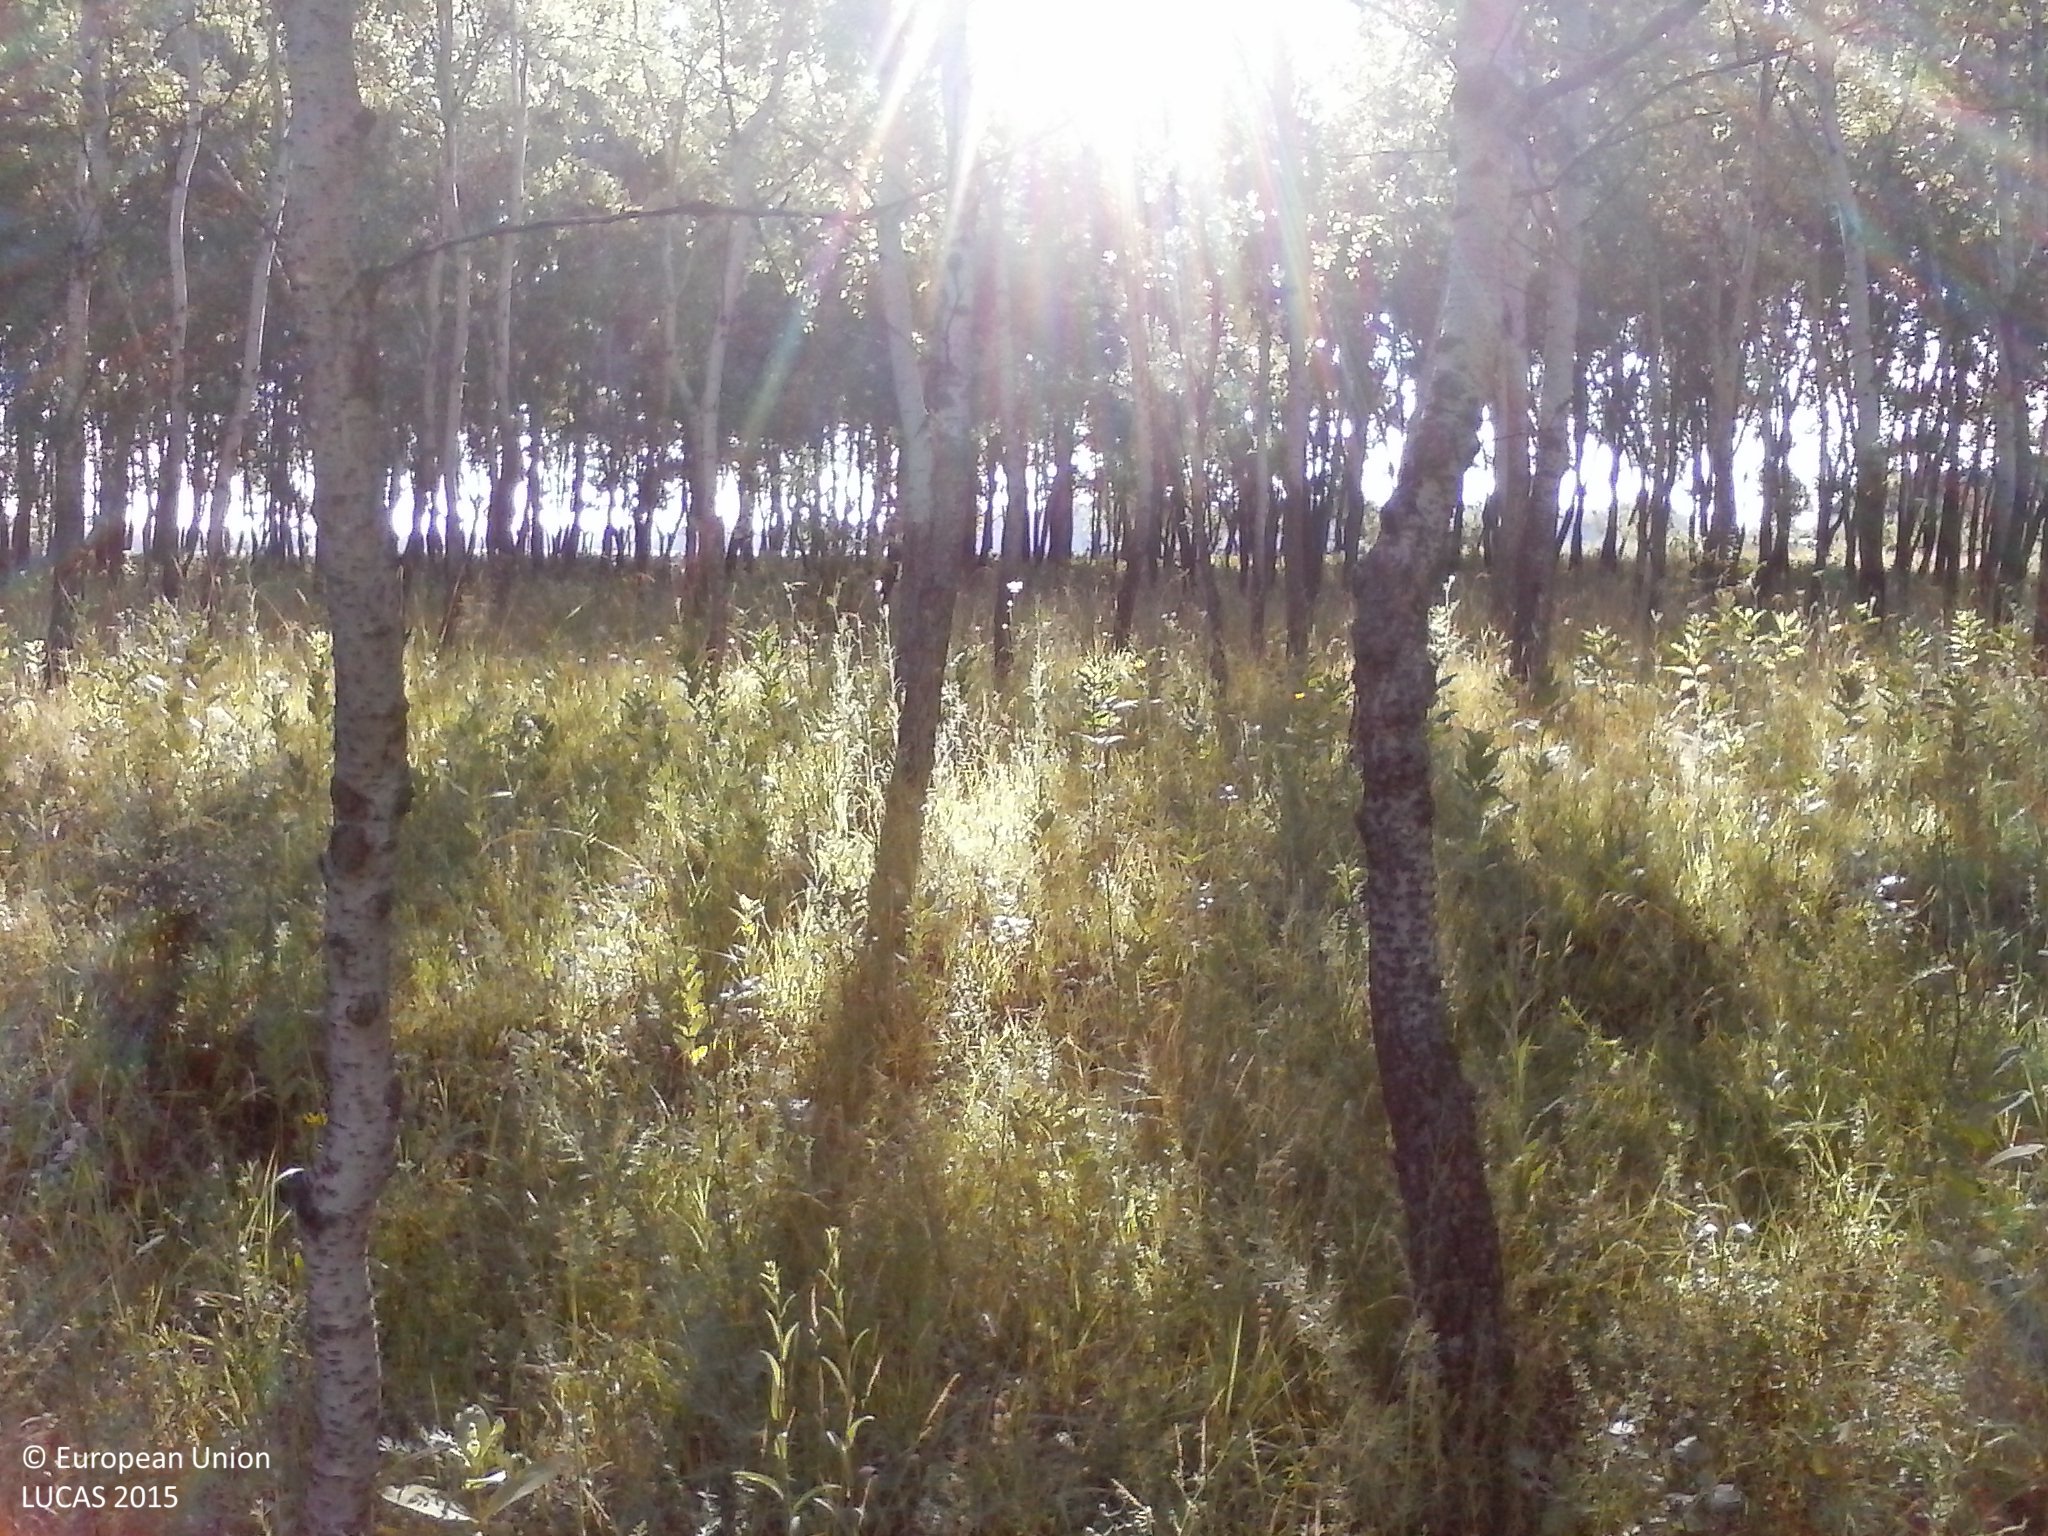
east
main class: Woodland
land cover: Broadleaved woodland
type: non-riverine alder, birch or aspen forest
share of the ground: > 75 %
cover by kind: broadleaved forest trees 80 %, herbaceous plants 15 %, shrubs 5 %
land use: Forestry
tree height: > 5 m
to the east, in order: Broadleaved woodland; Grassland without tree/shrub cover; Fences; Spontaneously vegetated surfaces; Fences; Grassland without tree/shrub cover
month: July
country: HU
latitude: 46.3789
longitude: 19.5211
